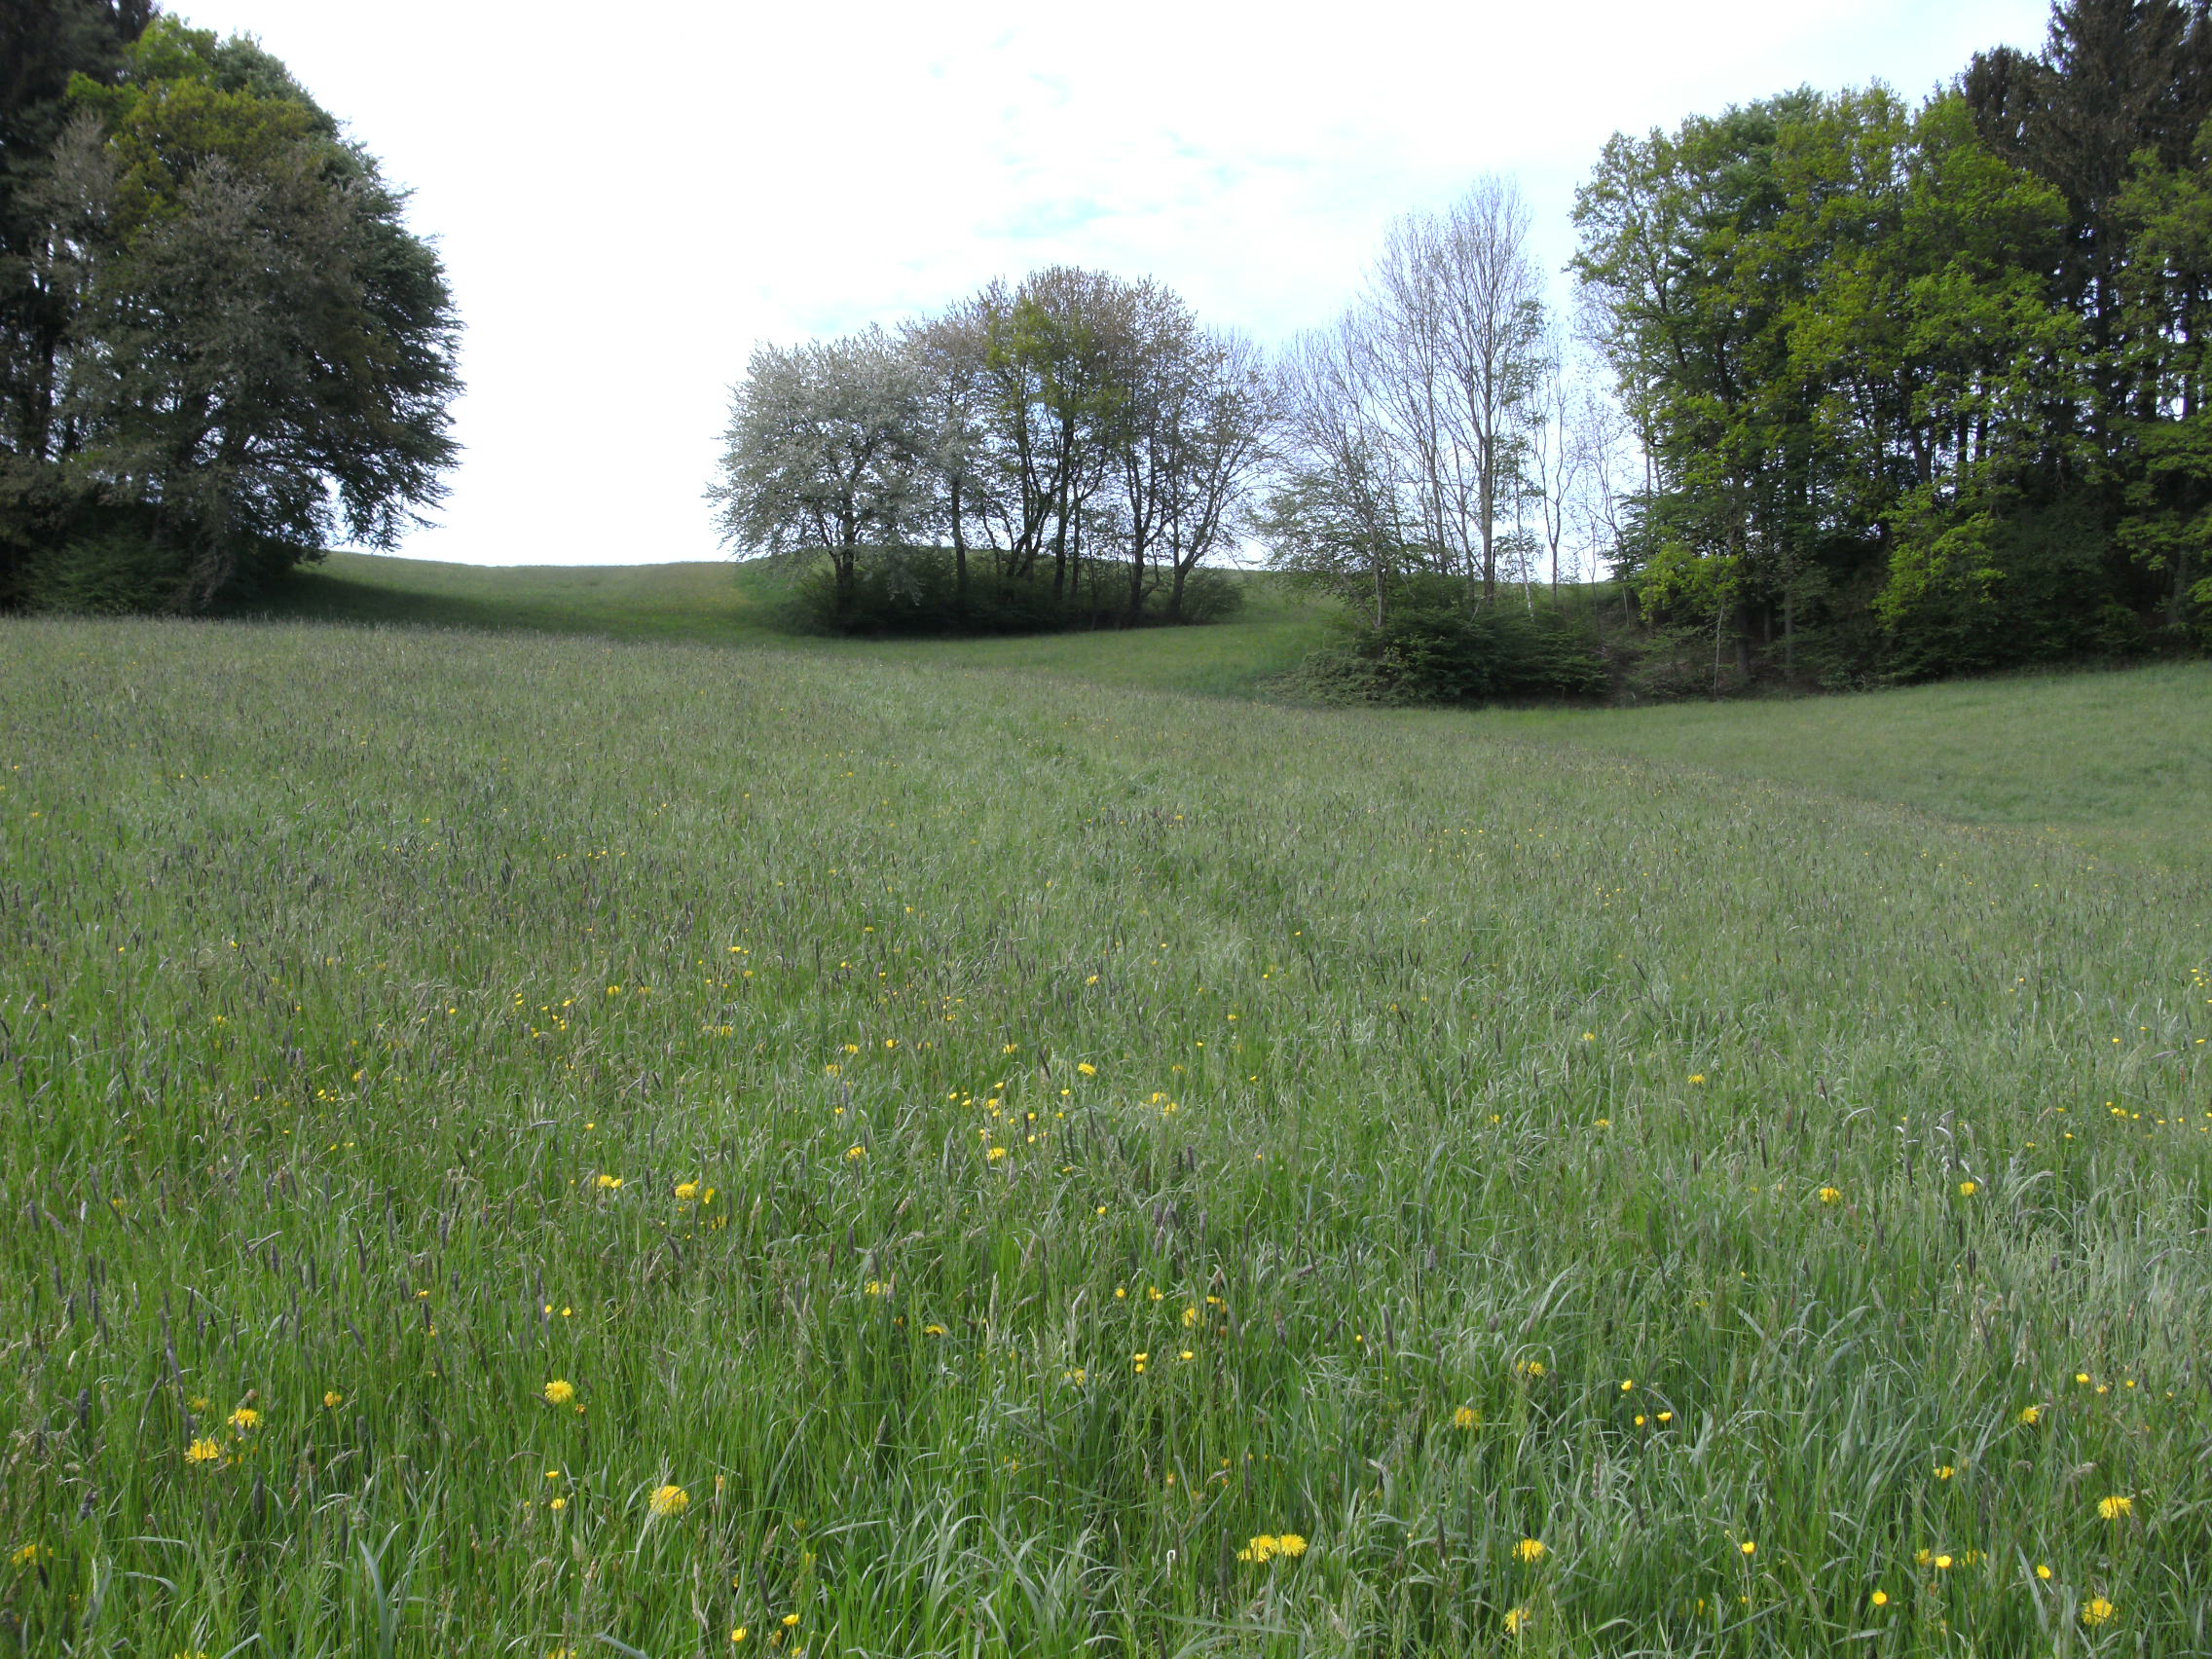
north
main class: Grassland
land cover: Grassland without tree/shrub cover
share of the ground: > 75 %
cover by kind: herbaceous plants 100 %
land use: Agriculture (excluding fallow land and kitchen gardens)
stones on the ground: < 10 %
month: May
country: AT
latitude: 48.1360
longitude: 13.3720
